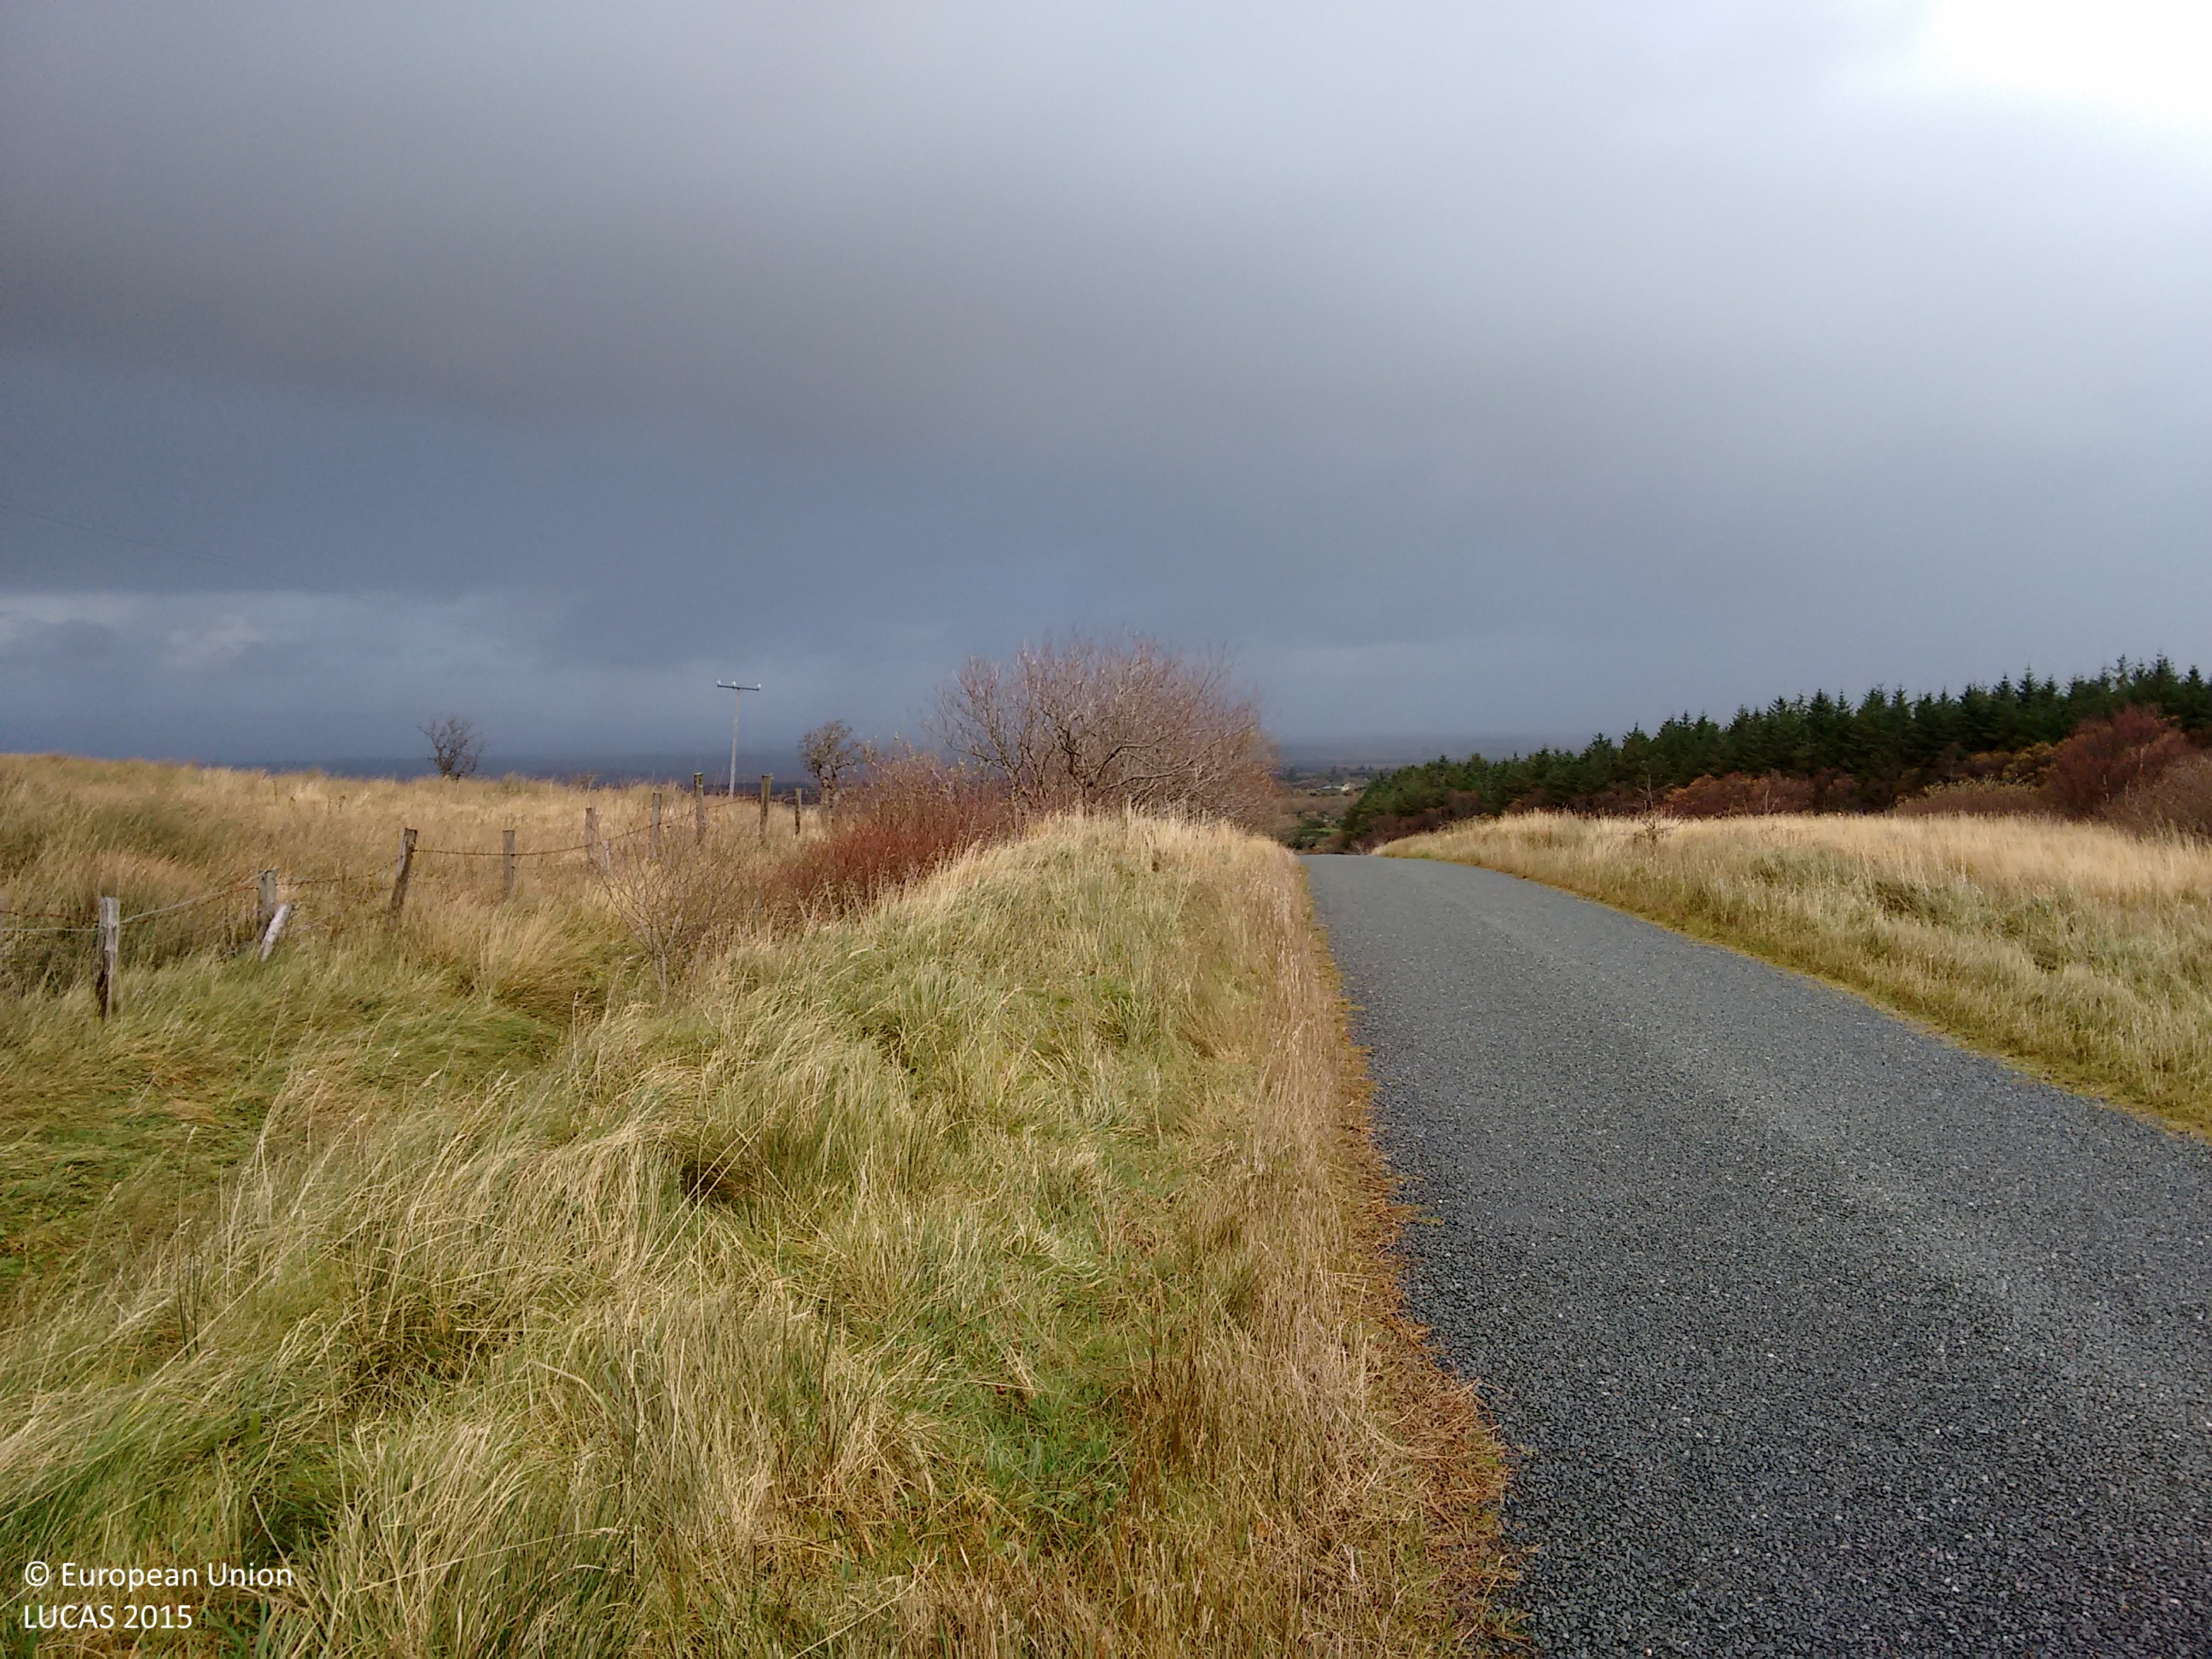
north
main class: Grassland
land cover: Grassland without tree/shrub cover
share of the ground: > 75 %
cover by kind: herbaceous plants 100 %
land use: Agriculture (excluding fallow land and kitchen gardens)
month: November
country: IE
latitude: 54.3935
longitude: -8.4078
